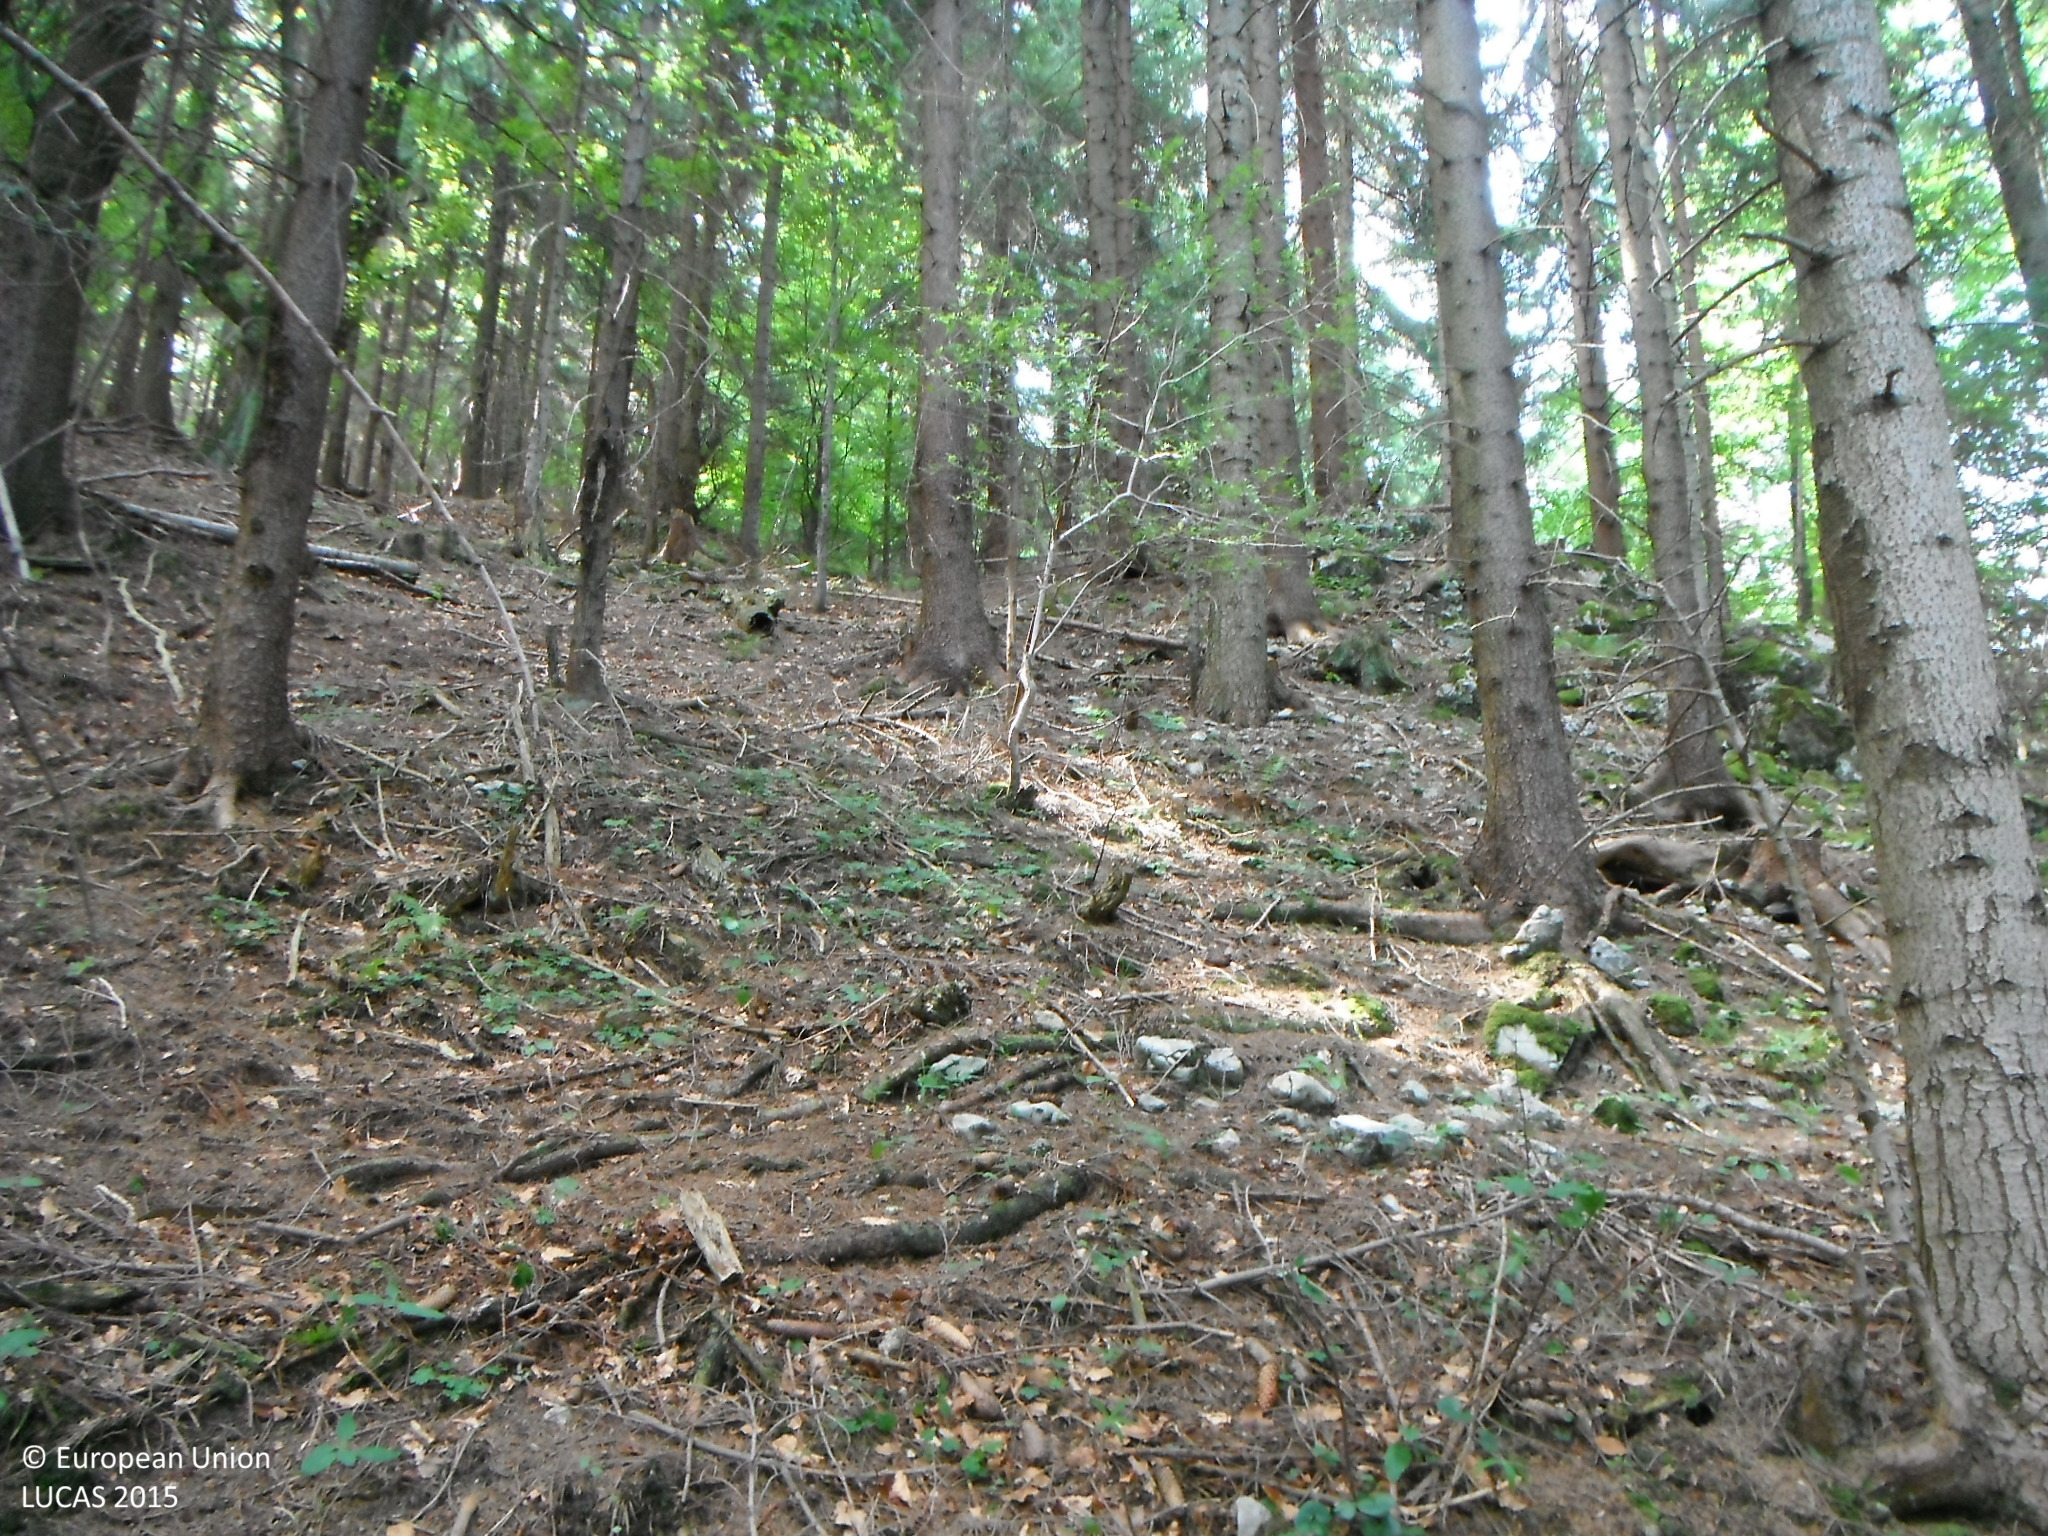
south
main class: Woodland
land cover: Spruce dominated coniferous woodland
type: alpine coniferous forest
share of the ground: > 75 %
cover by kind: coniferous forest trees 95 %, broadleaved forest trees 5 %
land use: Forestry
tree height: > 5 m
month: July
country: SK
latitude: 49.2560
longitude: 19.1324
